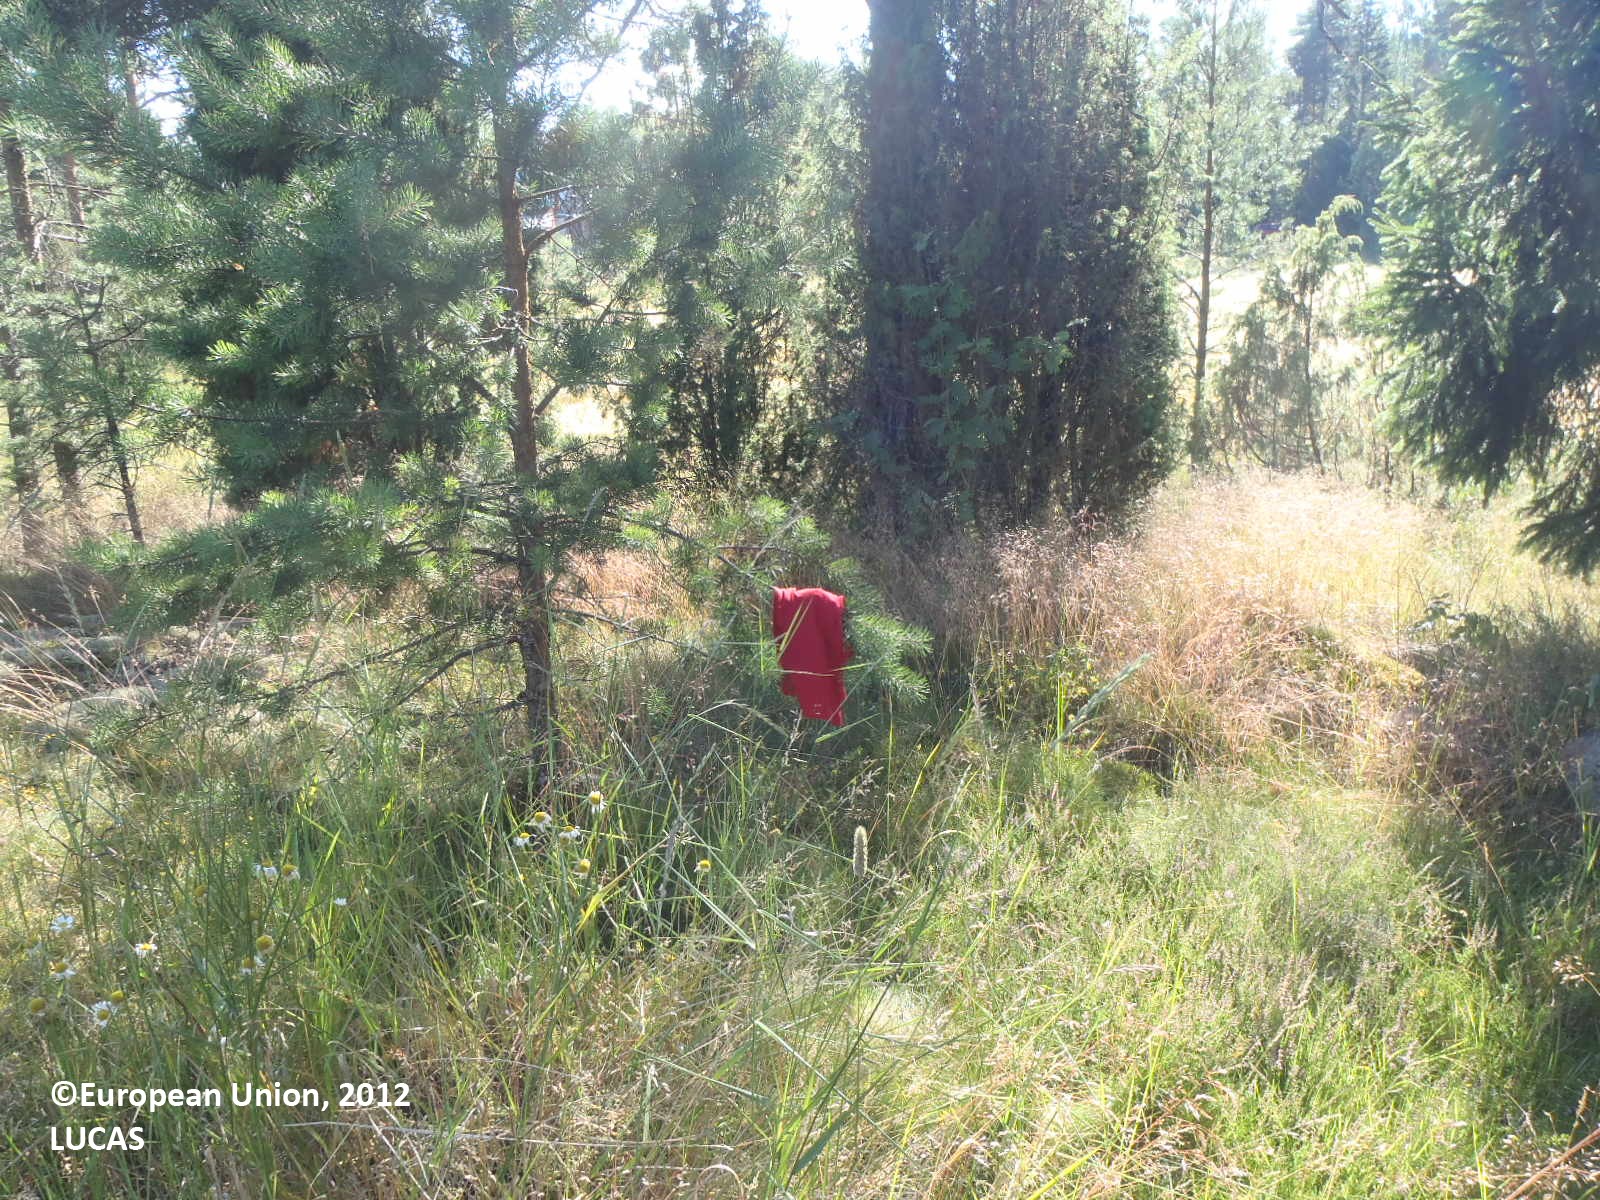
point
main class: Woodland
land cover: Pine dominated coniferous woodland
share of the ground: 25 - 50 %
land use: Forestry
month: July
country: FI
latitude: 60.6572
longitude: 21.7117
